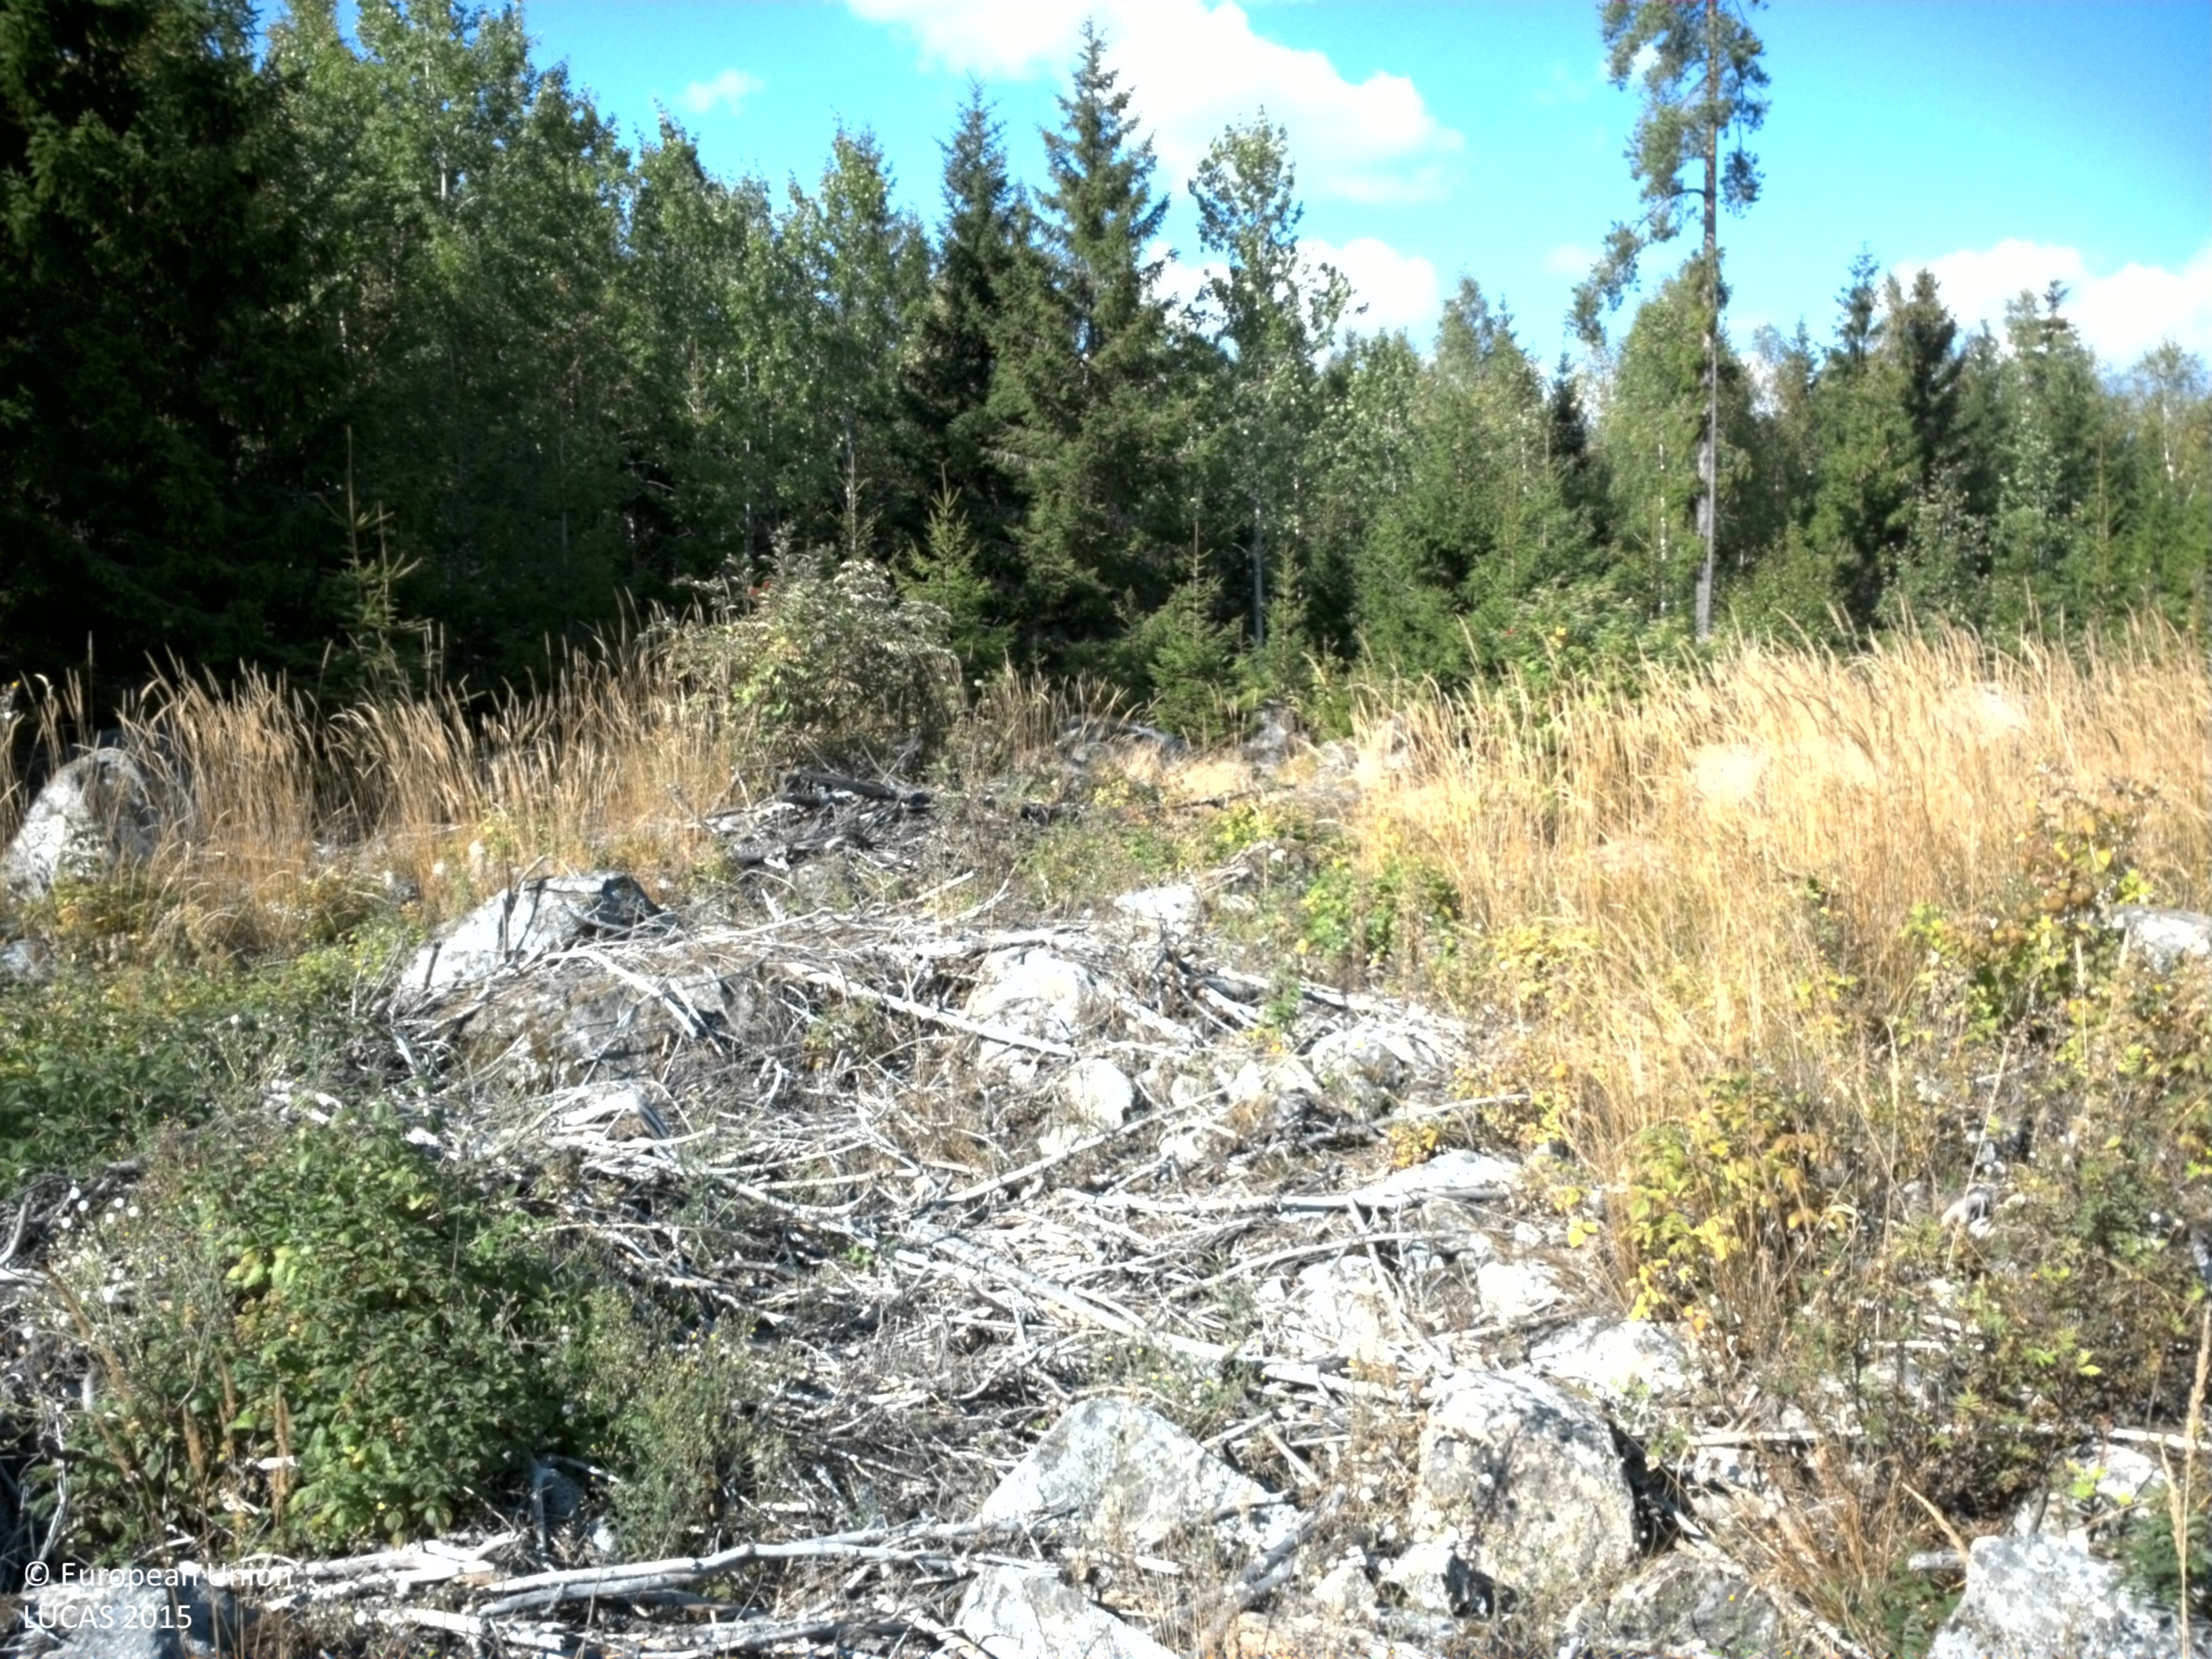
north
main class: Woodland
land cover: Broadleaved woodland
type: boreal forest
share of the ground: 25 - 50 %
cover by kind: herbaceous plants 45 %, broadleaved forest trees 30 %, shrubs 15 %, coniferous forest trees 5 %, consolidated bare surface 5 %
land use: Forestry
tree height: < 5 m
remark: Clear cut
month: August
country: SE
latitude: 60.0964
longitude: 17.7080
